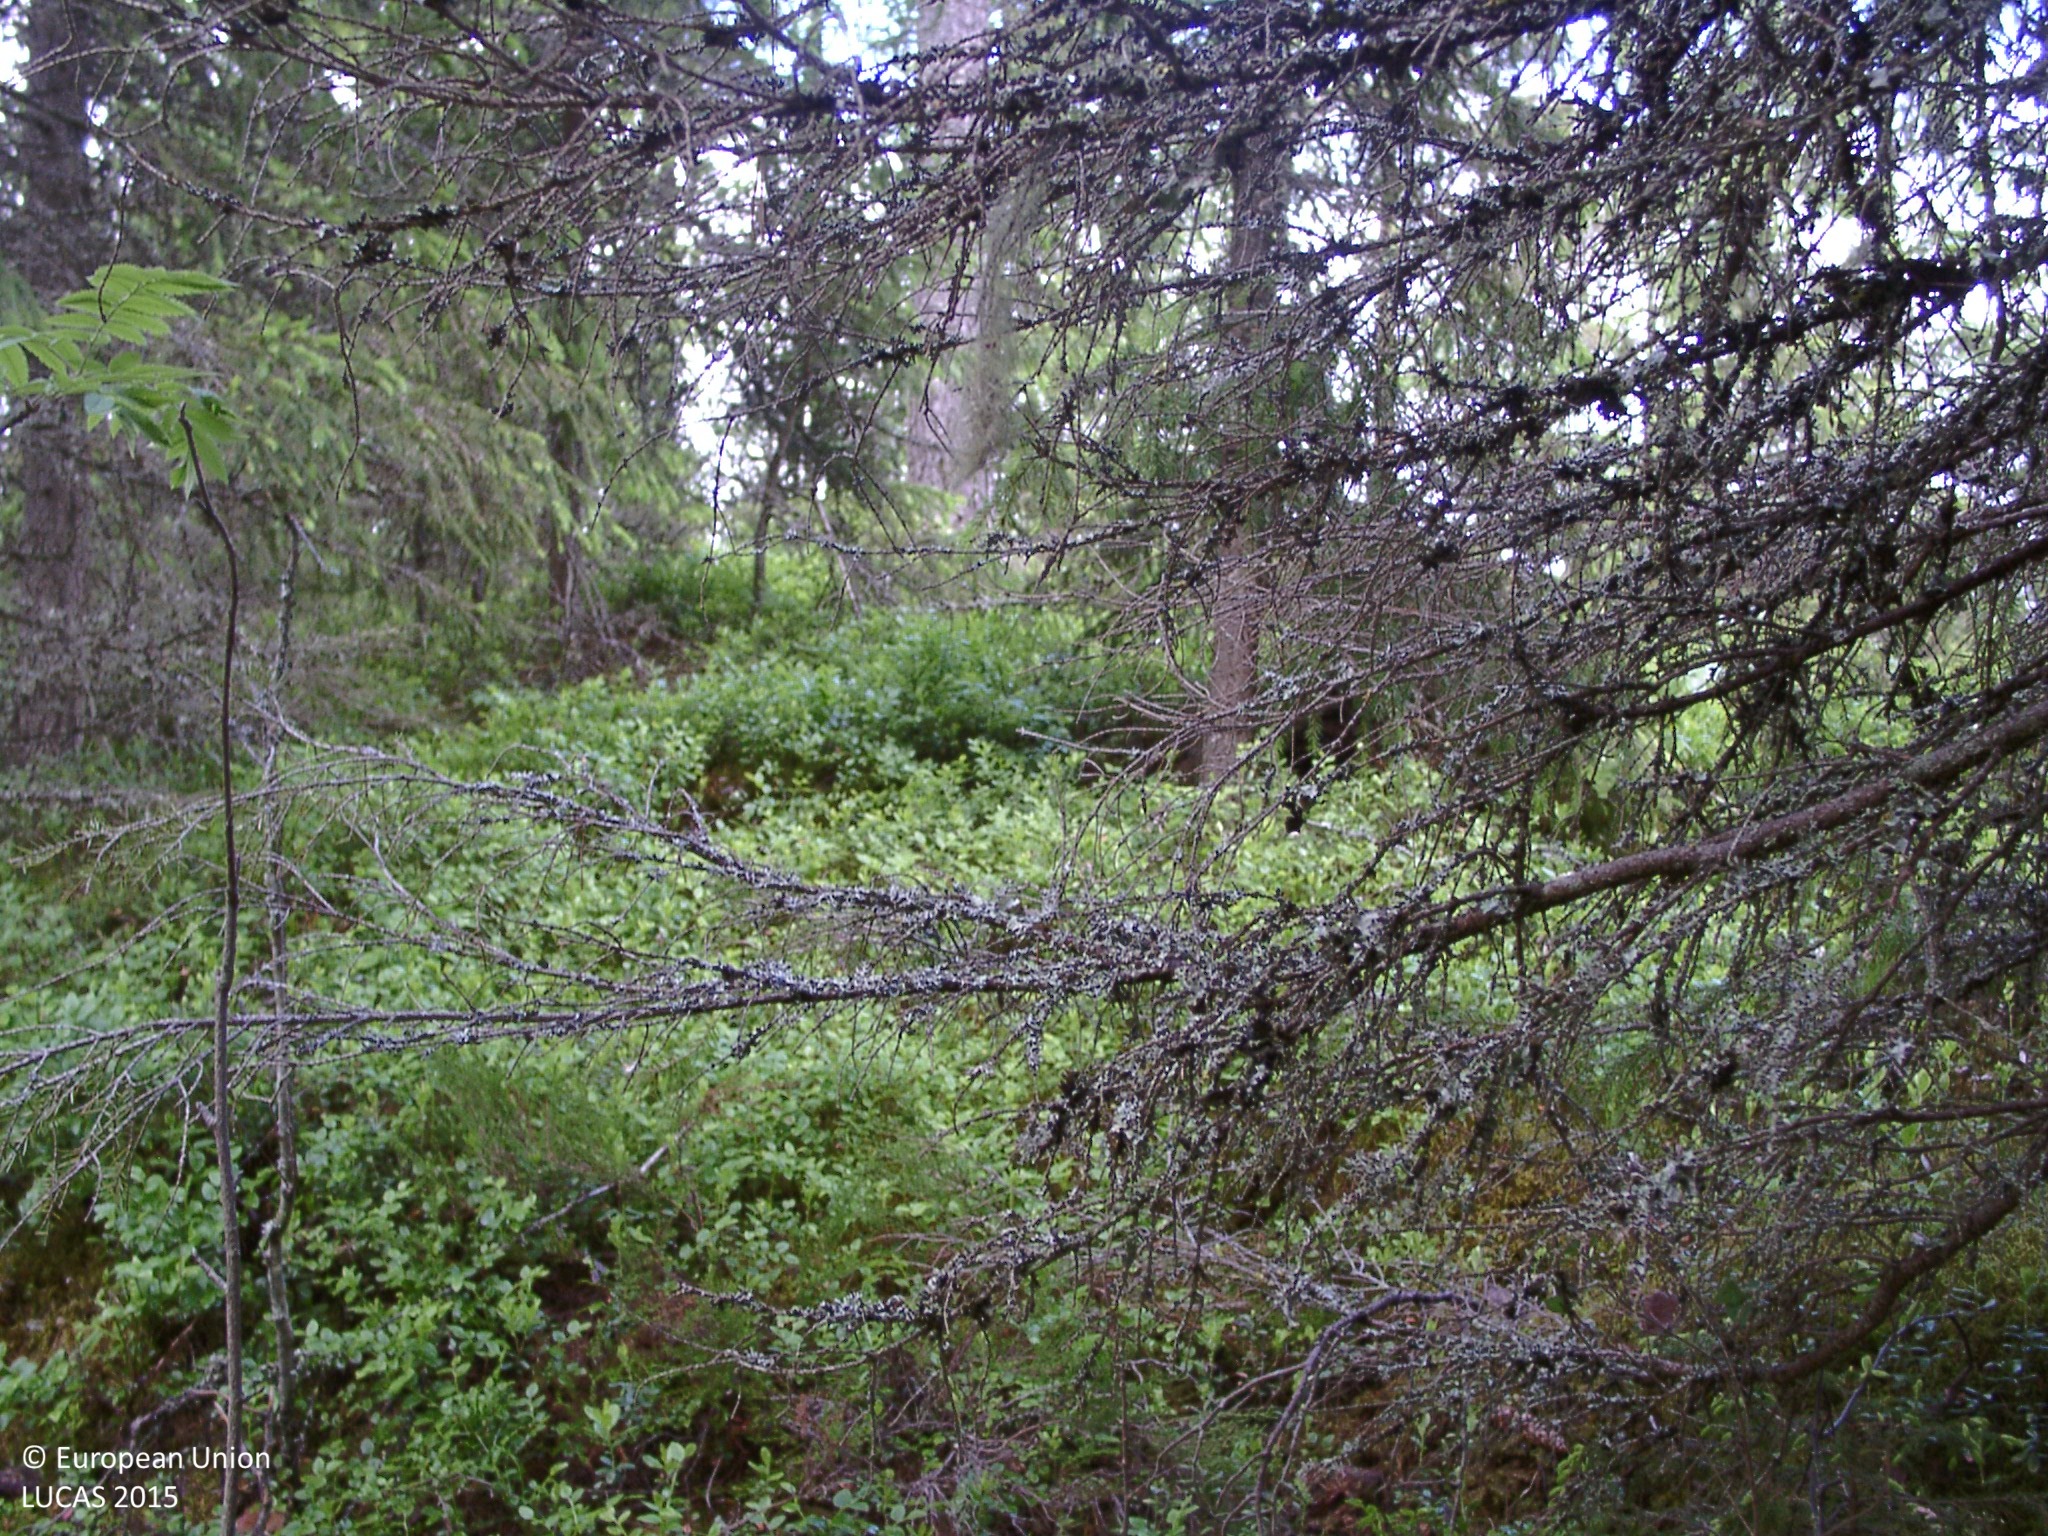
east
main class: Woodland
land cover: Spruce dominated mixed woodland
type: boreal forest
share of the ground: 50 - 75 %
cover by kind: coniferous forest trees 40 %, shrubs 30 %, broadleaved forest trees 20 %, herbaceous plants 5 %, lichens and mosses 5 %
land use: Forestry
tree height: > 5 m
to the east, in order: Spruce dominated mixed woodland; Shrubland with sparse tree cover; Spruce dominated mixed woodland; Abandoned hedges; Spruce dominated mixed woodland; Abandoned hedges; Spruce dominated mixed woodland; Abandoned hedges; Spruce dominated mixed woodland; Grassland with sparse tree/shrub cover; Spruce dominated mixed woodland
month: June
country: FI
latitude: 61.5427
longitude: 24.9895
